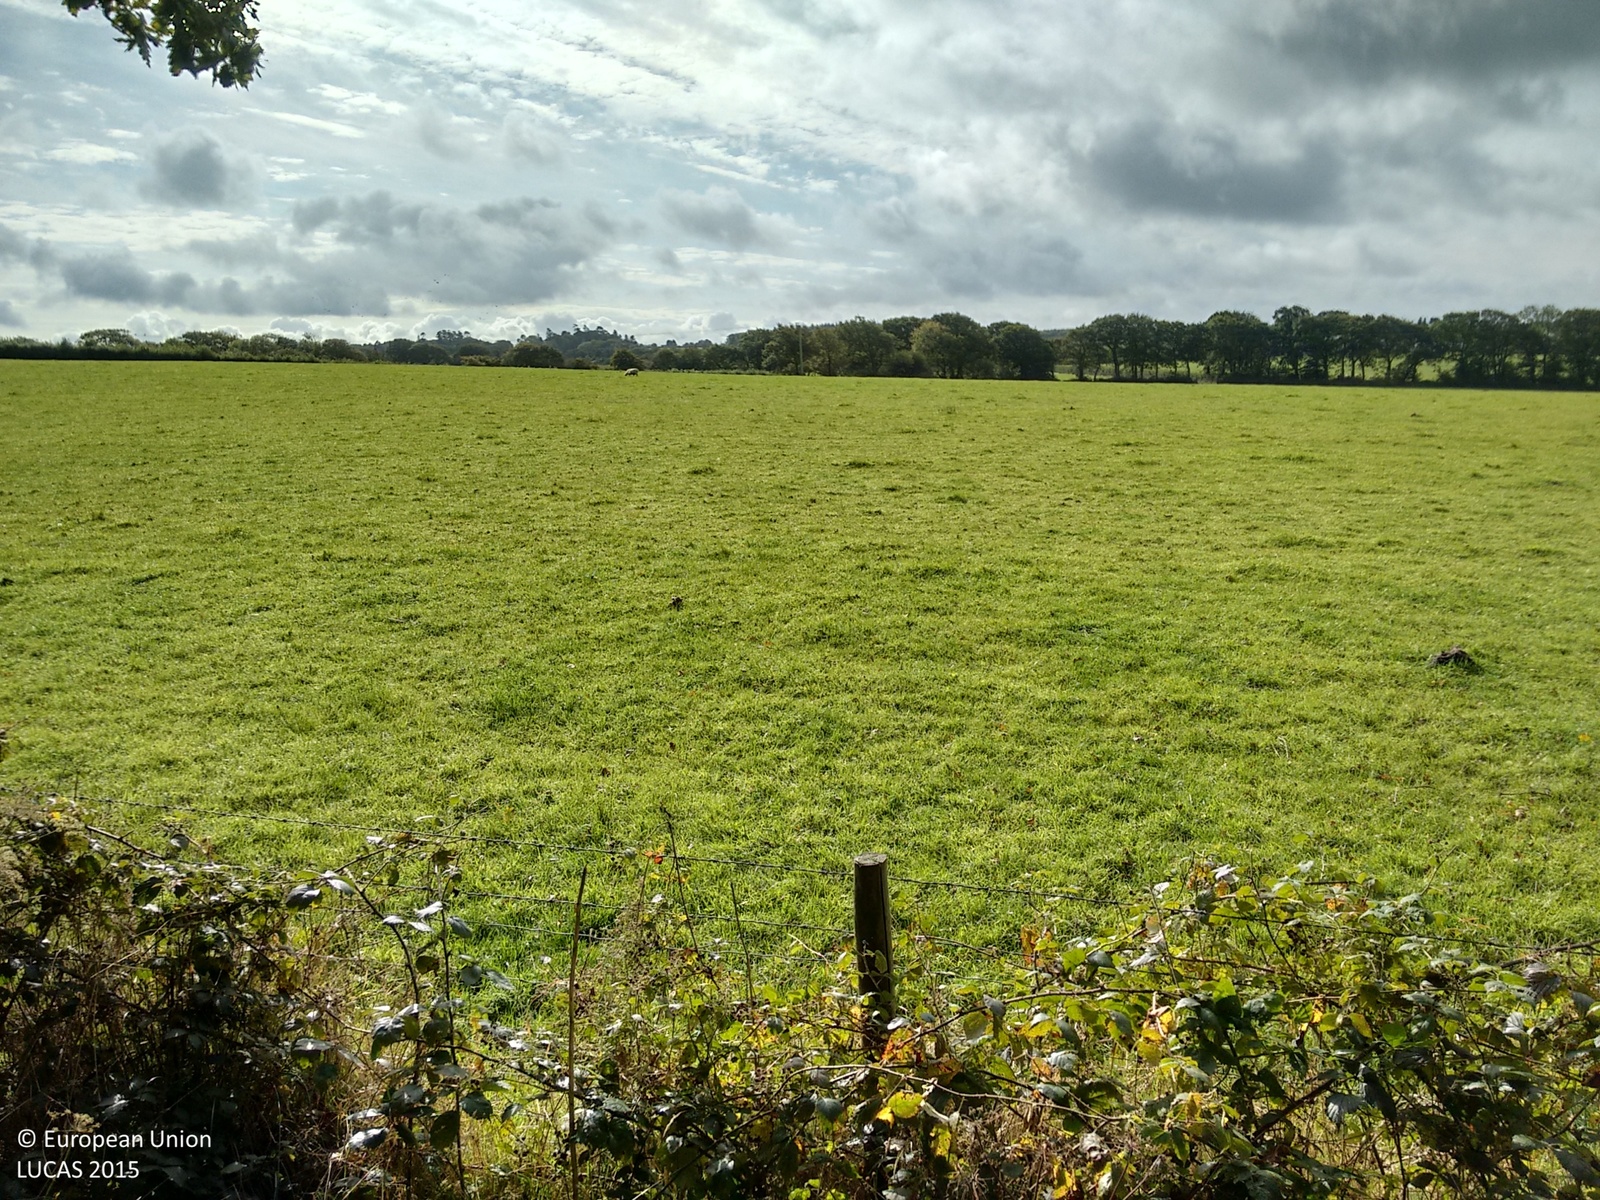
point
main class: Grassland
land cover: Grassland without tree/shrub cover
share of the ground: > 75 %
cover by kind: herbaceous plants 100 %
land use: Agriculture (excluding fallow land and kitchen gardens)
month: September
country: GB
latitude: 50.8244
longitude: -4.1949
